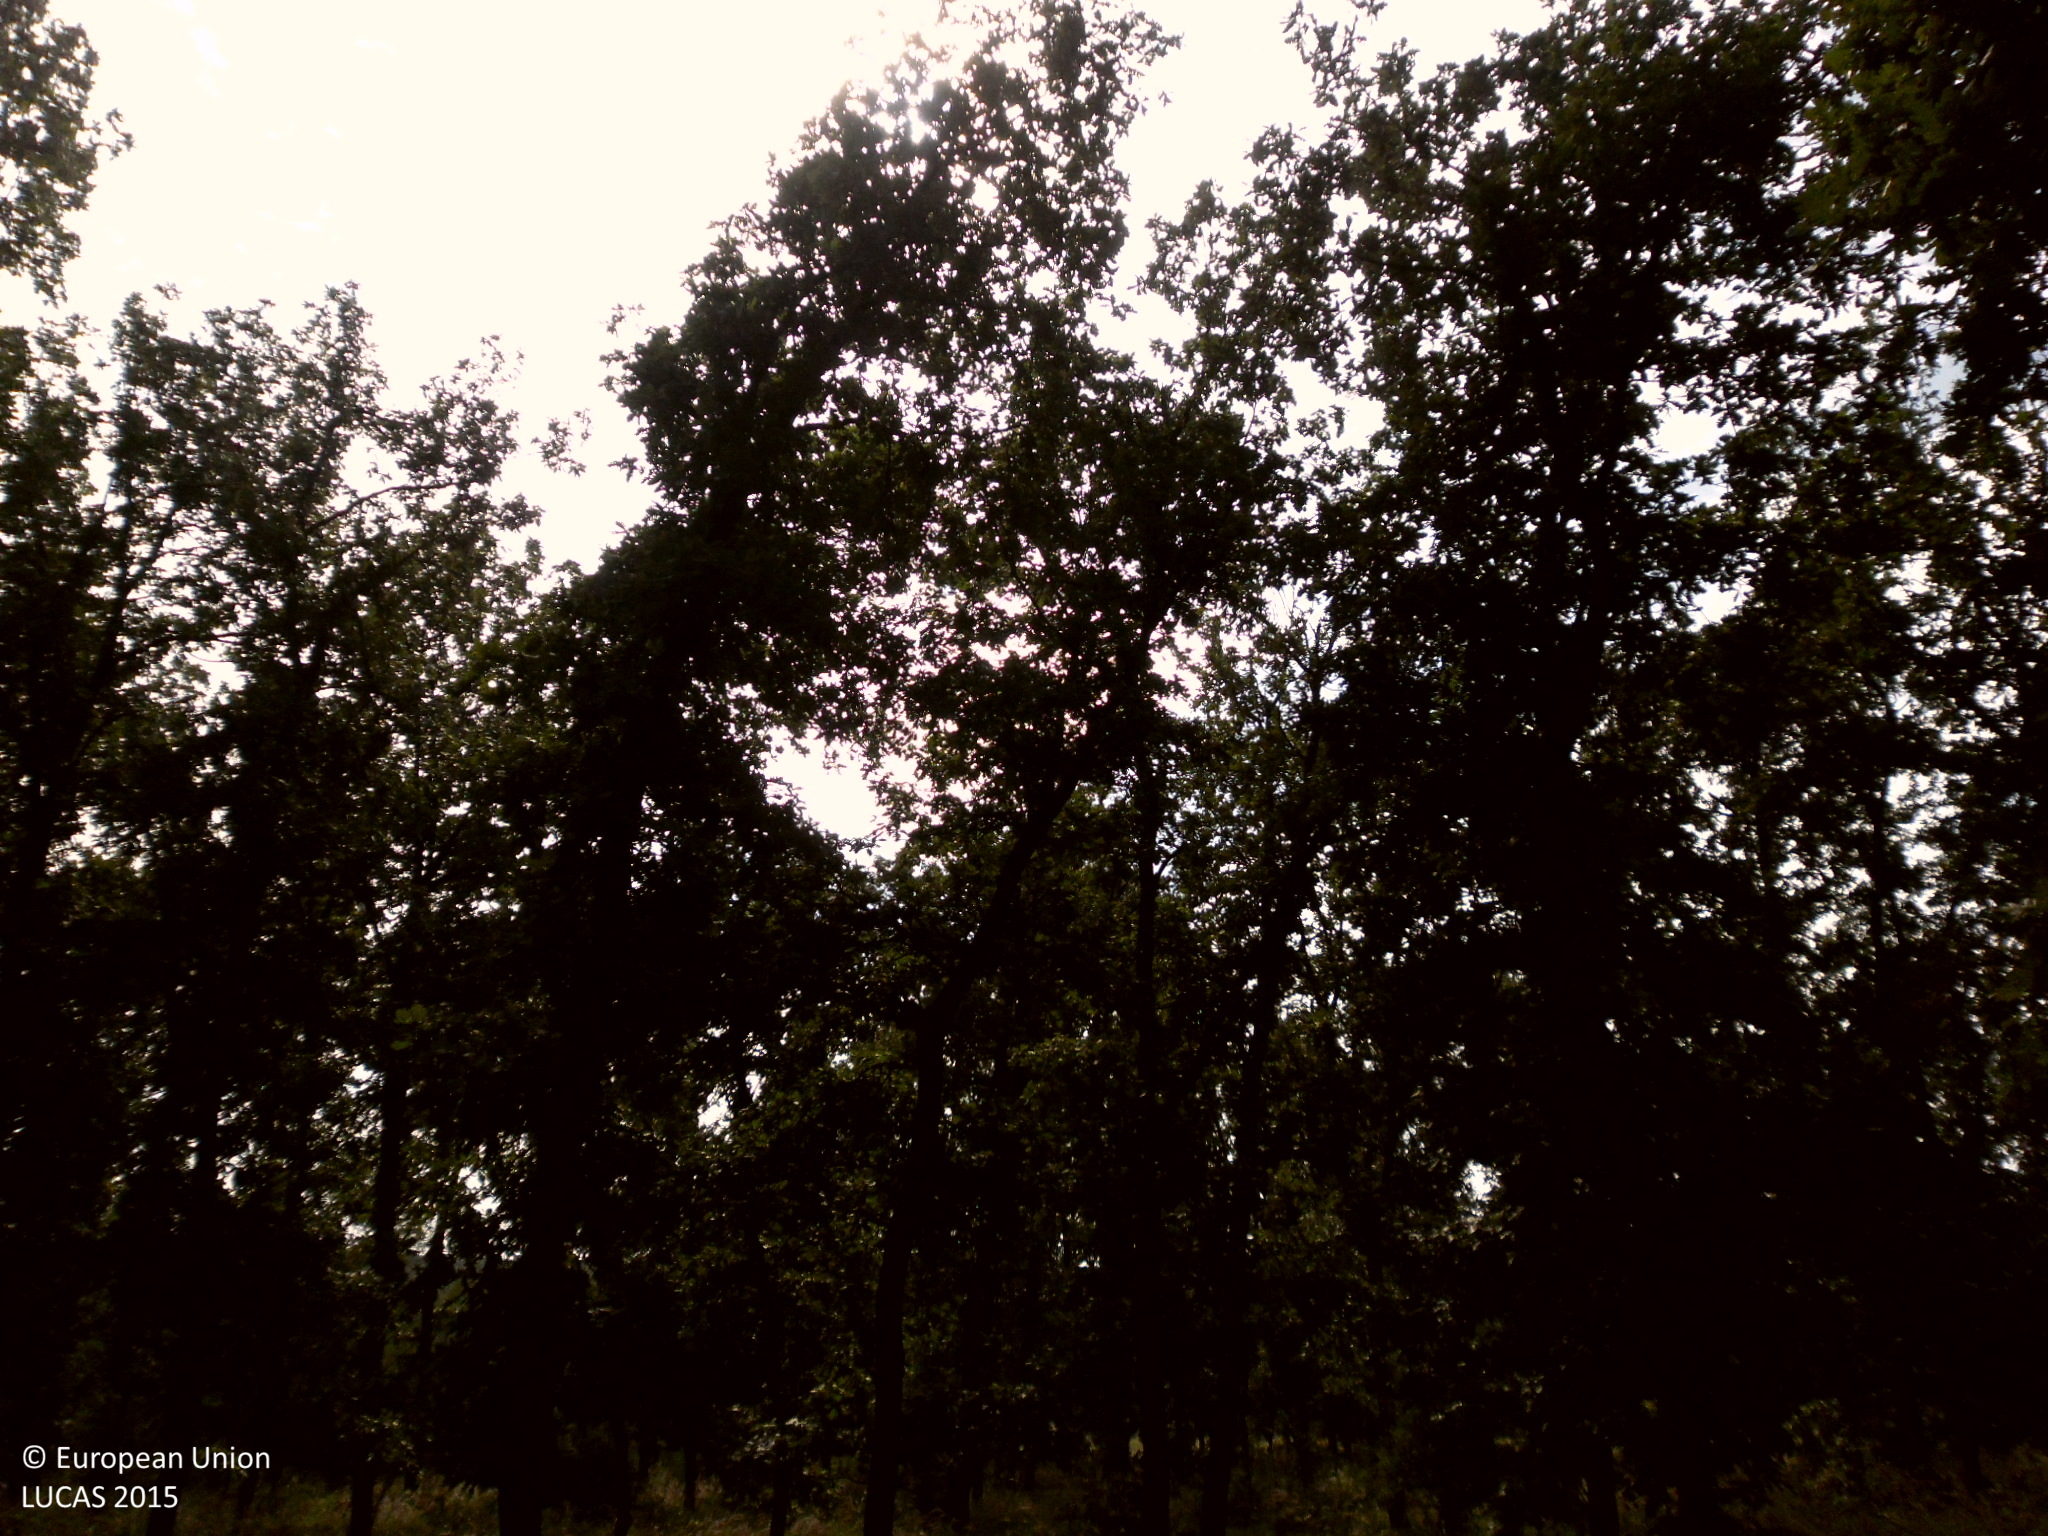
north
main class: Woodland
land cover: Broadleaved woodland
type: mesophytic deciduous forest
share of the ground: > 75 %
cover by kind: broadleaved forest trees 80 %, herbaceous plants 20 %
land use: Forestry
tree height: > 5 m
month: October
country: BG
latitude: 43.9903
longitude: 22.6676
